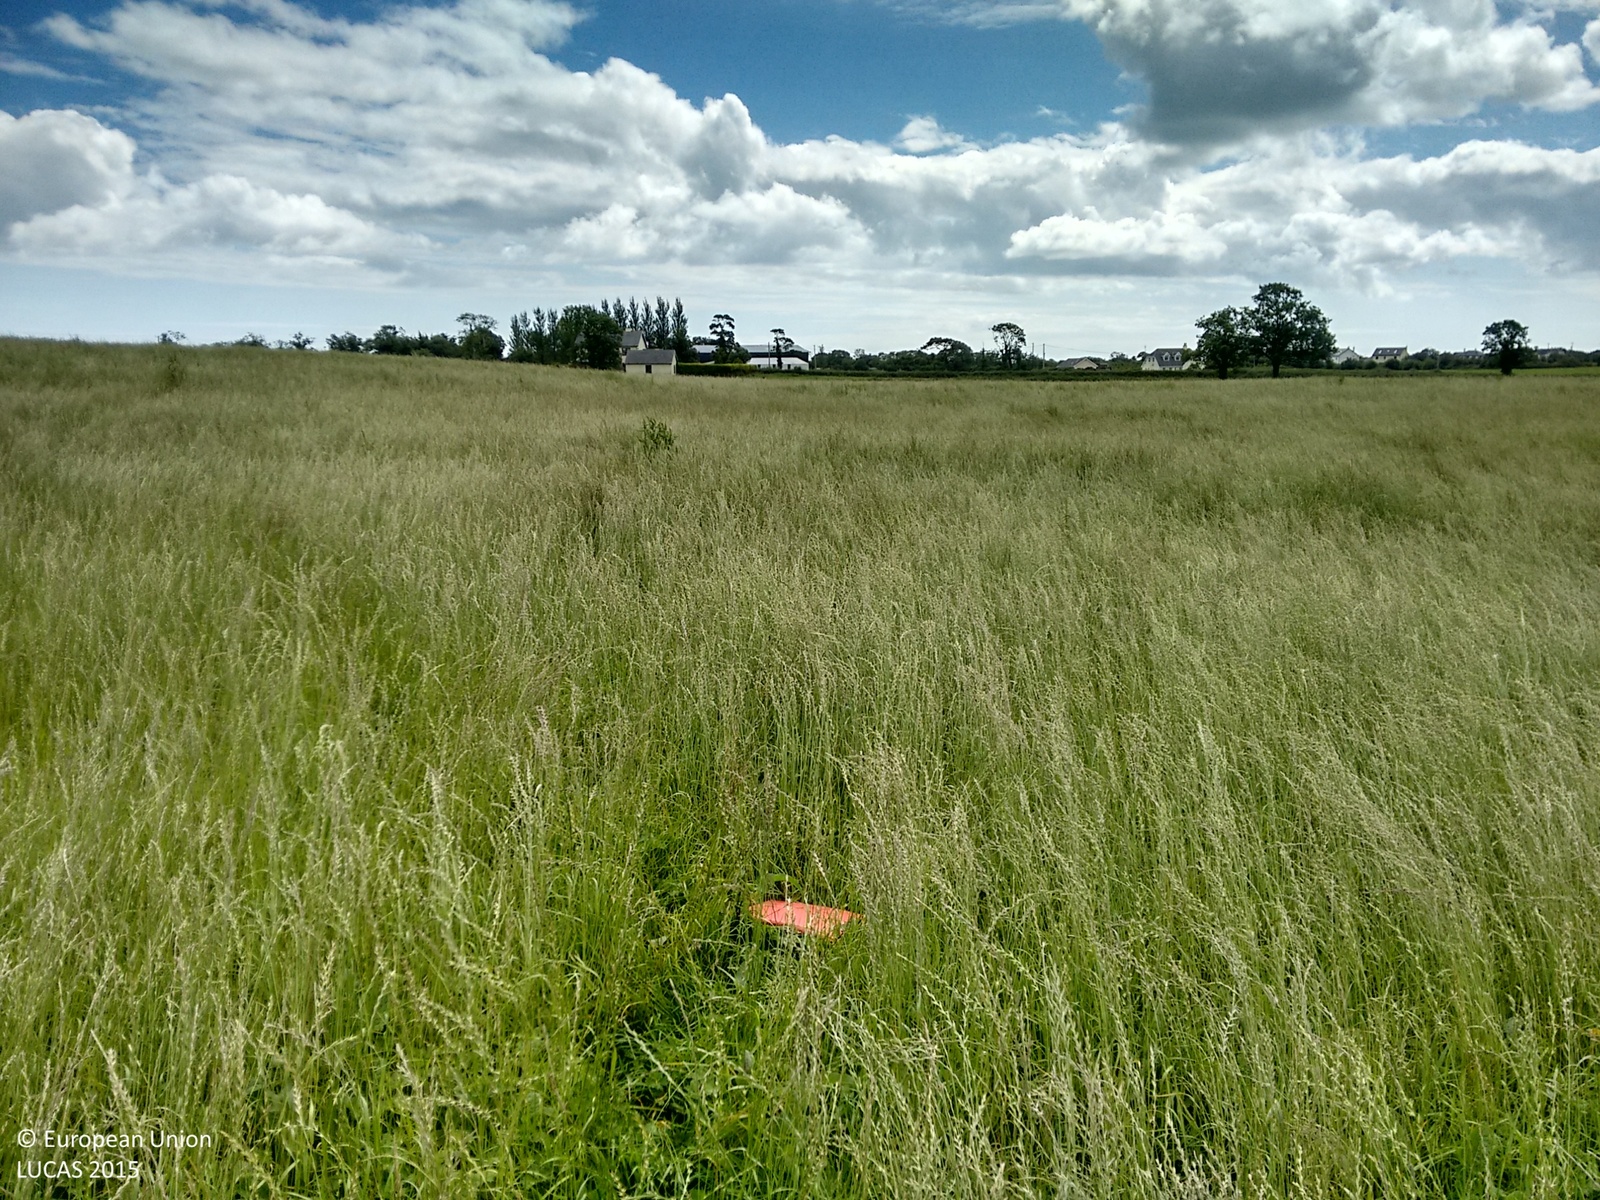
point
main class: Grassland
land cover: Grassland without tree/shrub cover
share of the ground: > 75 %
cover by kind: herbaceous plants 100 %
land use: Agriculture (excluding fallow land and kitchen gardens)
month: August
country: IE
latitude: 52.6781
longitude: -6.2573
